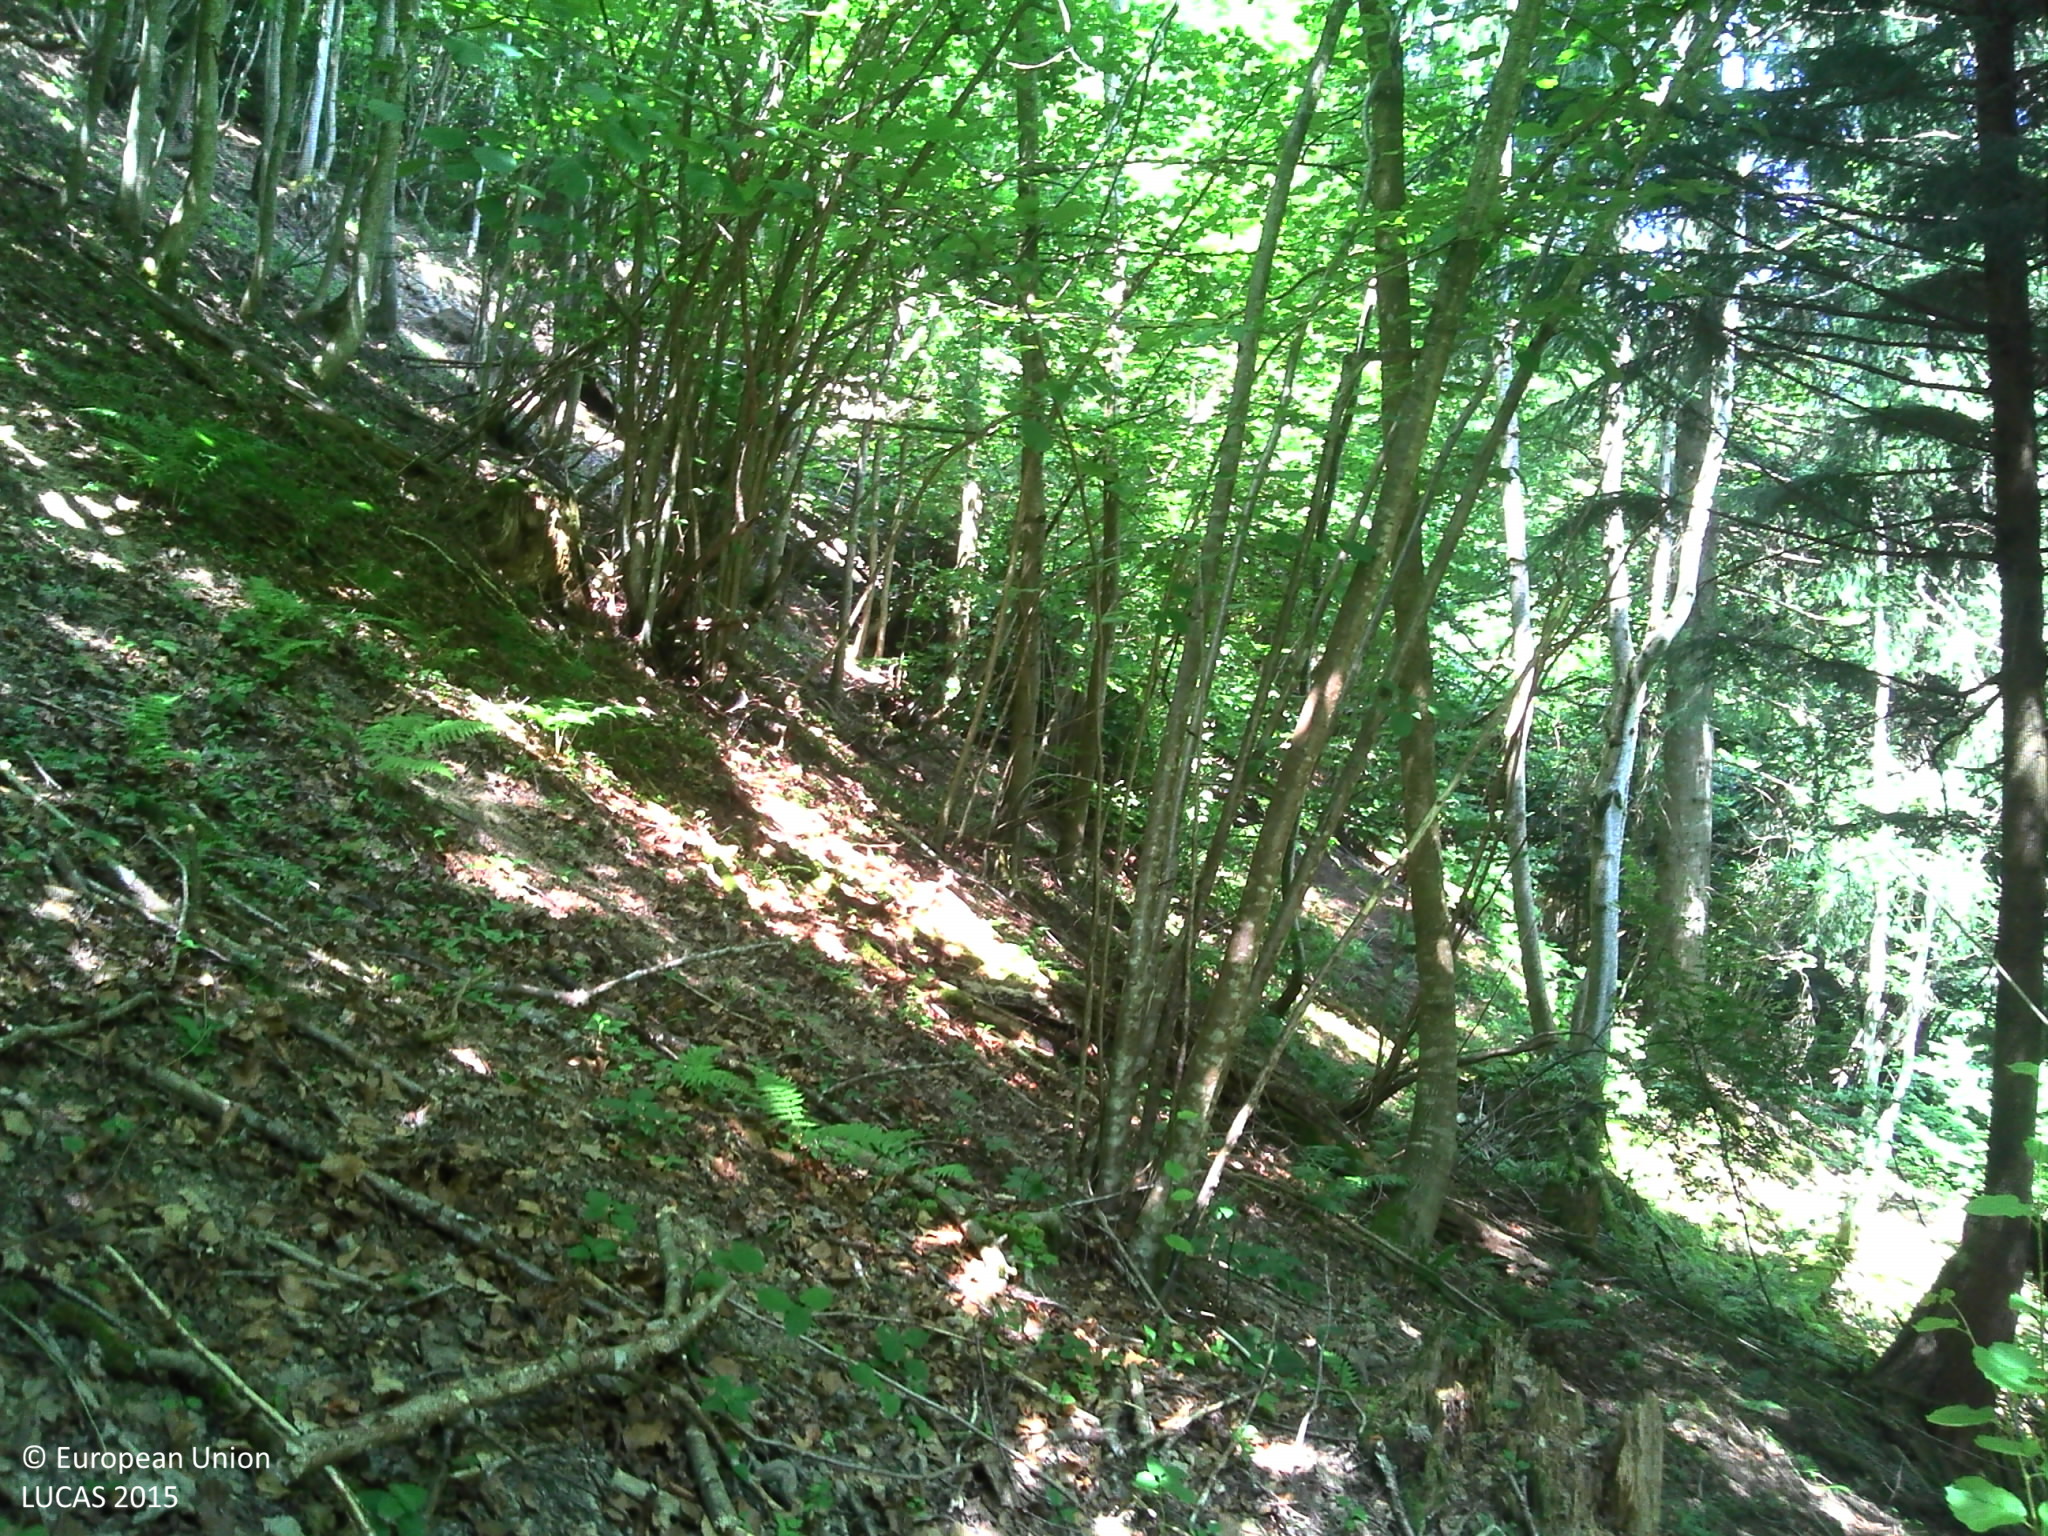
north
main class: Woodland
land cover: Spruce dominated mixed woodland
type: mountainous beech forest
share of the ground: > 75 %
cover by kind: broadleaved forest trees 40 %, coniferous forest trees 35 %, herbaceous plants 20 %, lichens and mosses 5 %
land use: Forestry
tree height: > 5 m
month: July
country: FR
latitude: 45.8871
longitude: 6.2026
